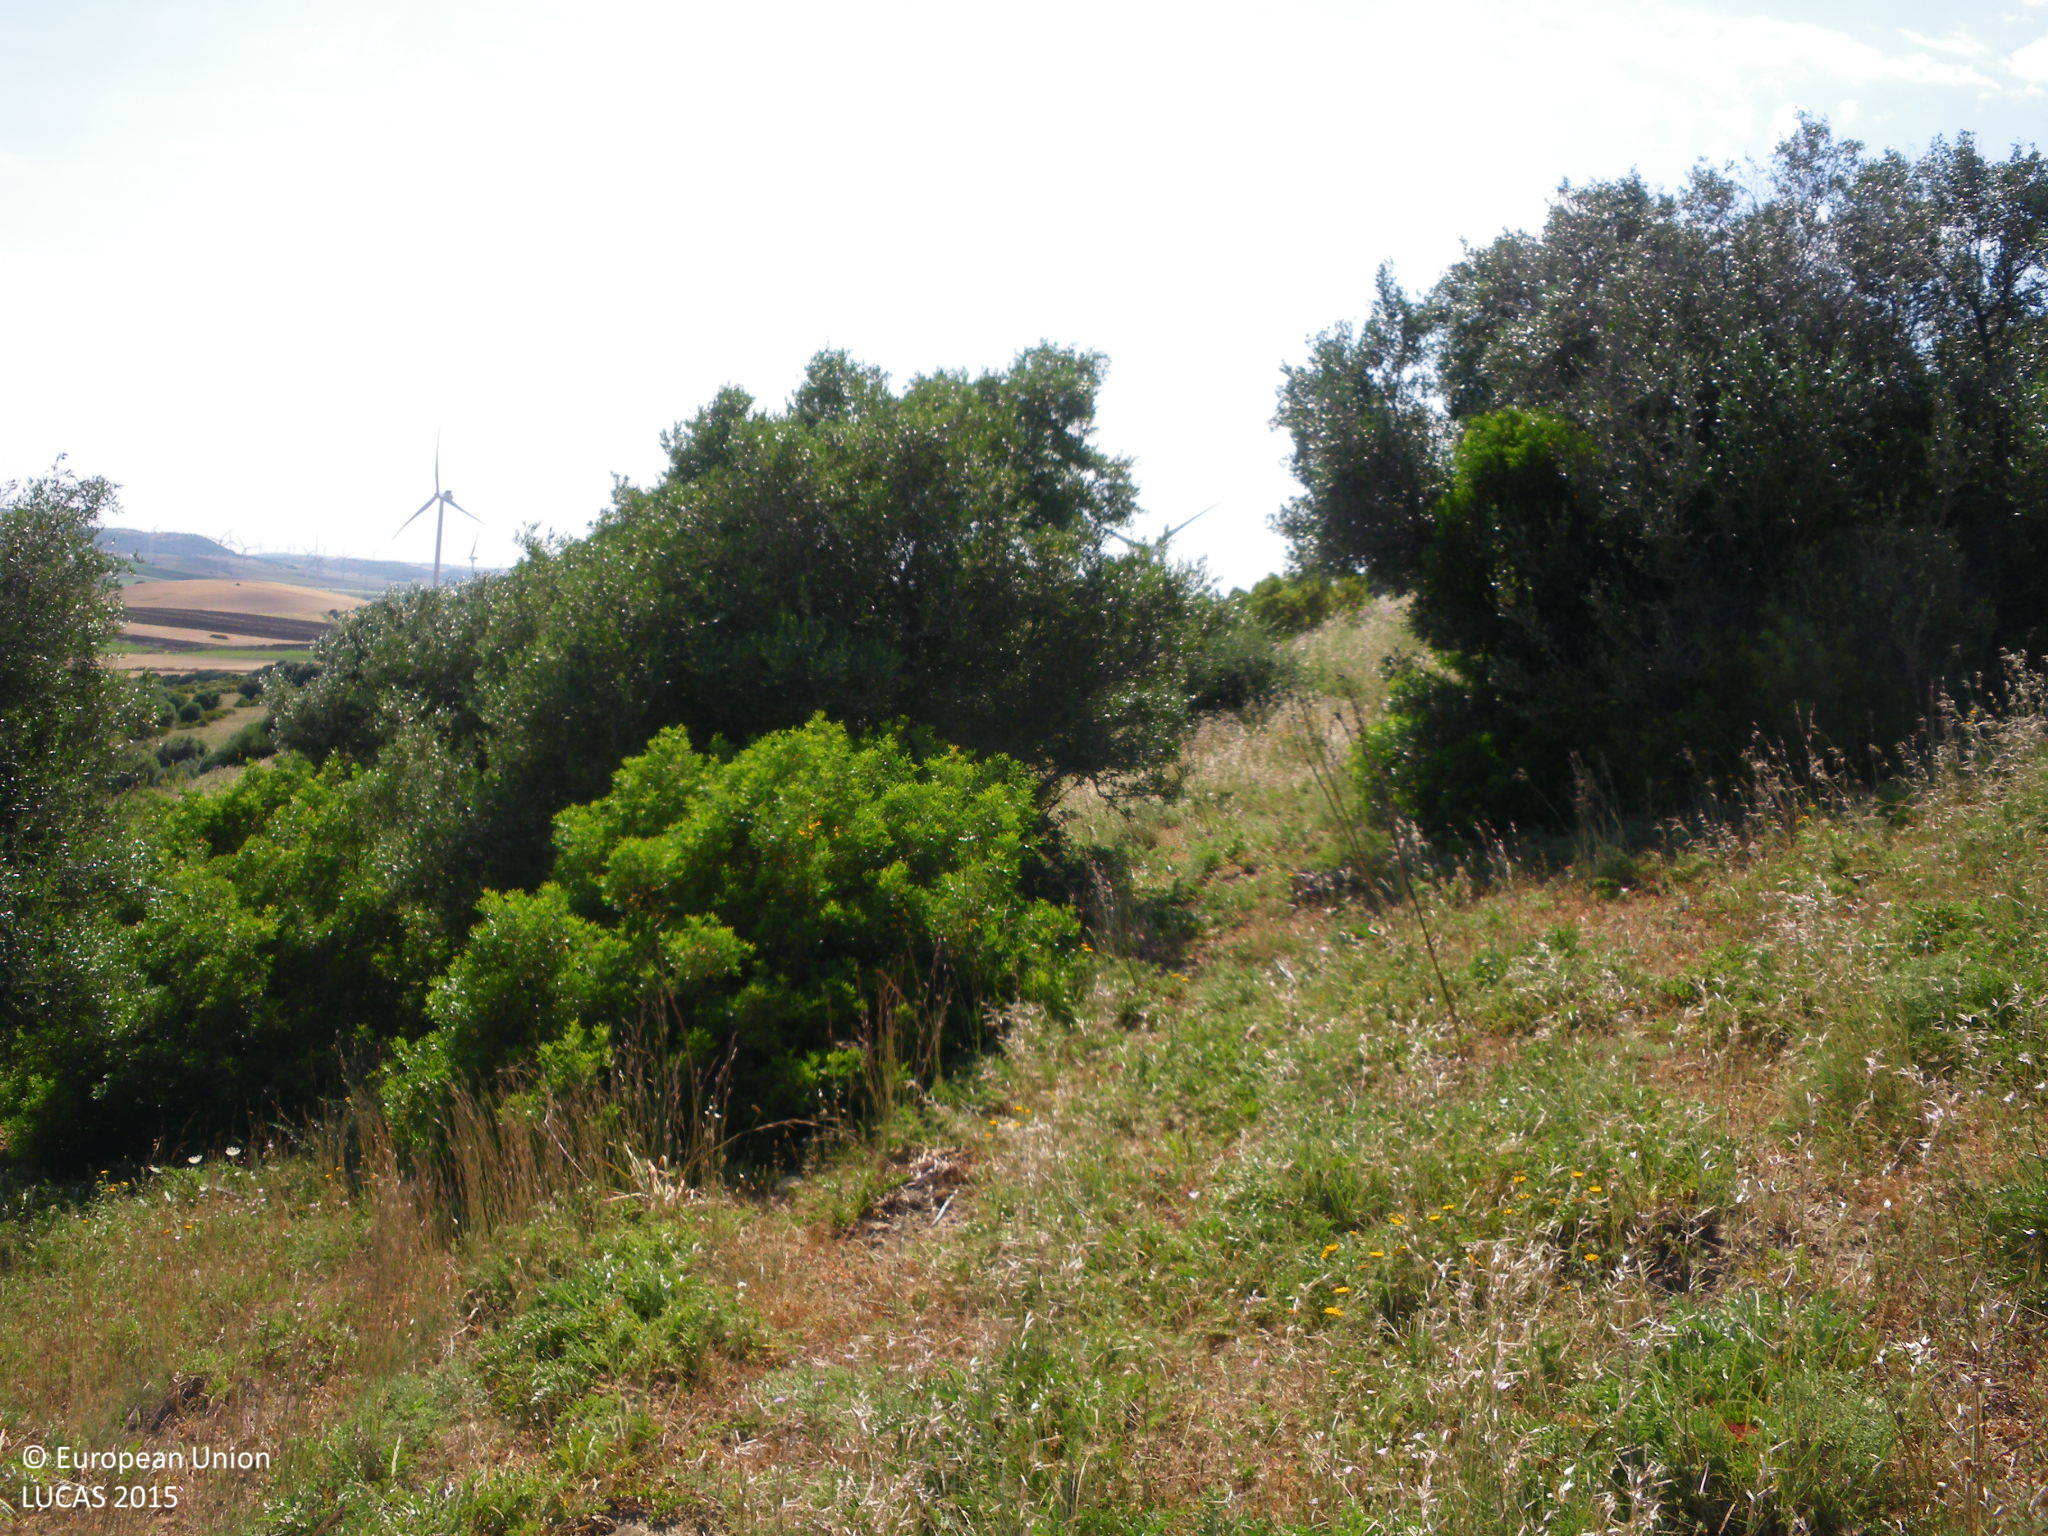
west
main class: Woodland
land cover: Broadleaved woodland
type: broadleaved evergreen forest
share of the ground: 10 - 25 %
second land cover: Grassland without tree/shrub cover
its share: > 75 %
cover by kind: herbaceous plants 80 %, broadleaved forest trees 10 %, shrubs 5 %, unconsolidated bare surface 5 %
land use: Forestry
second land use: Agriculture (excluding fallow land and kitchen gardens)
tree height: < 5 m
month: May
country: ES
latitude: 36.3449
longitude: -5.9016
